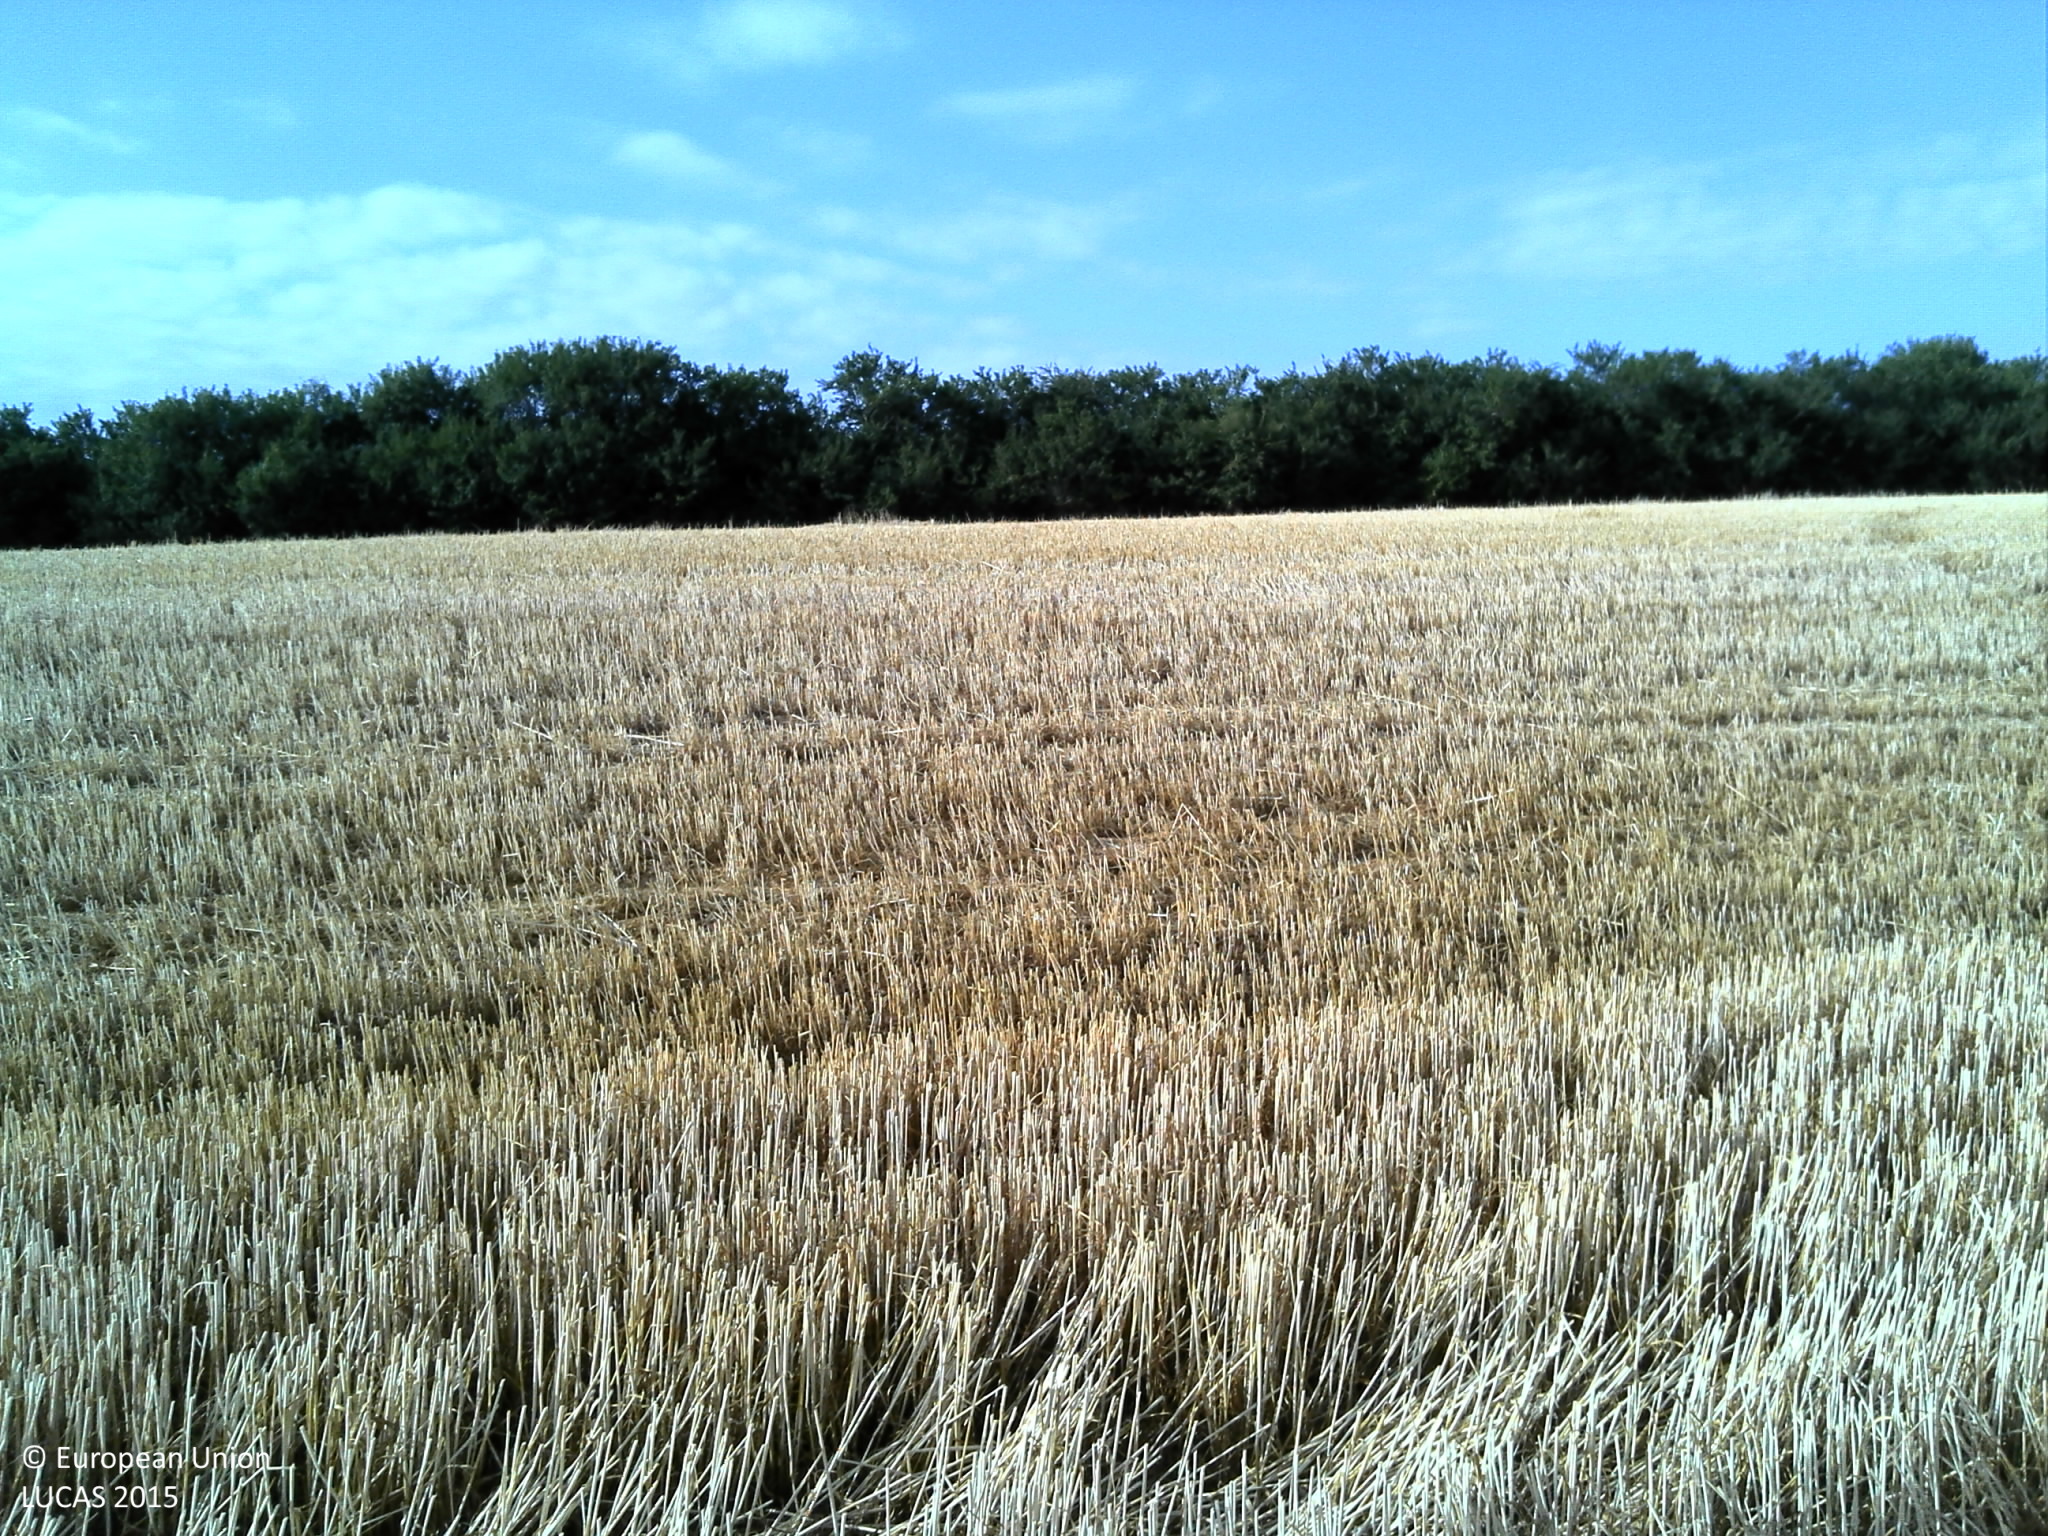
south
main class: Cropland
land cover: Common wheat
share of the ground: < 10 %
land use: Agriculture (excluding fallow land and kitchen gardens)
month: July
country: FR
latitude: 48.3565
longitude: 6.2081
